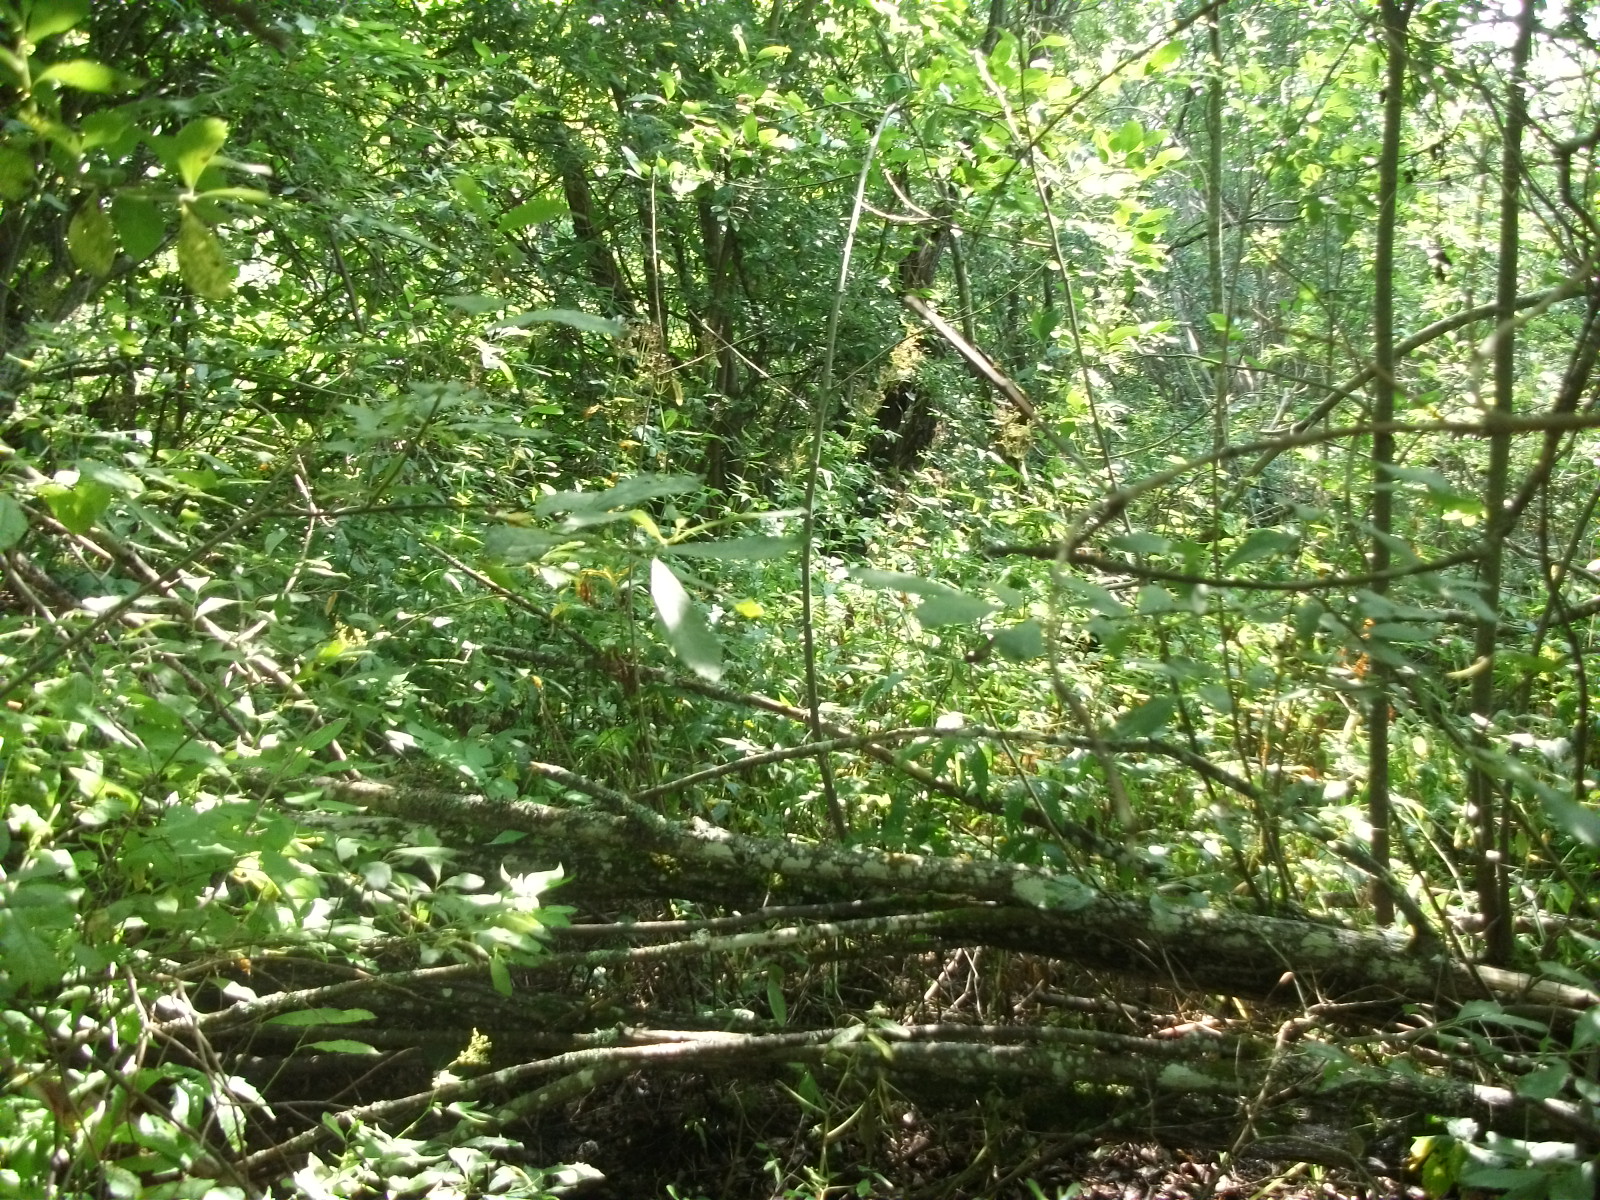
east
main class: Woodland
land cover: Broadleaved woodland
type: floodplain forest
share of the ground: > 75 %
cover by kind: broadleaved forest trees 80 %, shrubs 15 %, herbaceous plants 5 %
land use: Semi-natural and natural areas not in use
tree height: < 5 m
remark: Temporary flooded
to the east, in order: Broadleaved woodland; Spontaneously vegetated surfaces; Broadleaved woodland; Rivers and streams; Broadleaved woodland; Spontaneously vegetated surfaces; Electric lines; Grassland without tree/shrub cover; Broadleaved woodland; Rivers and streams; Broadleaved woodland; Grassland without tree/shrub cover
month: August
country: LV
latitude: 56.9260
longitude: 26.3919
